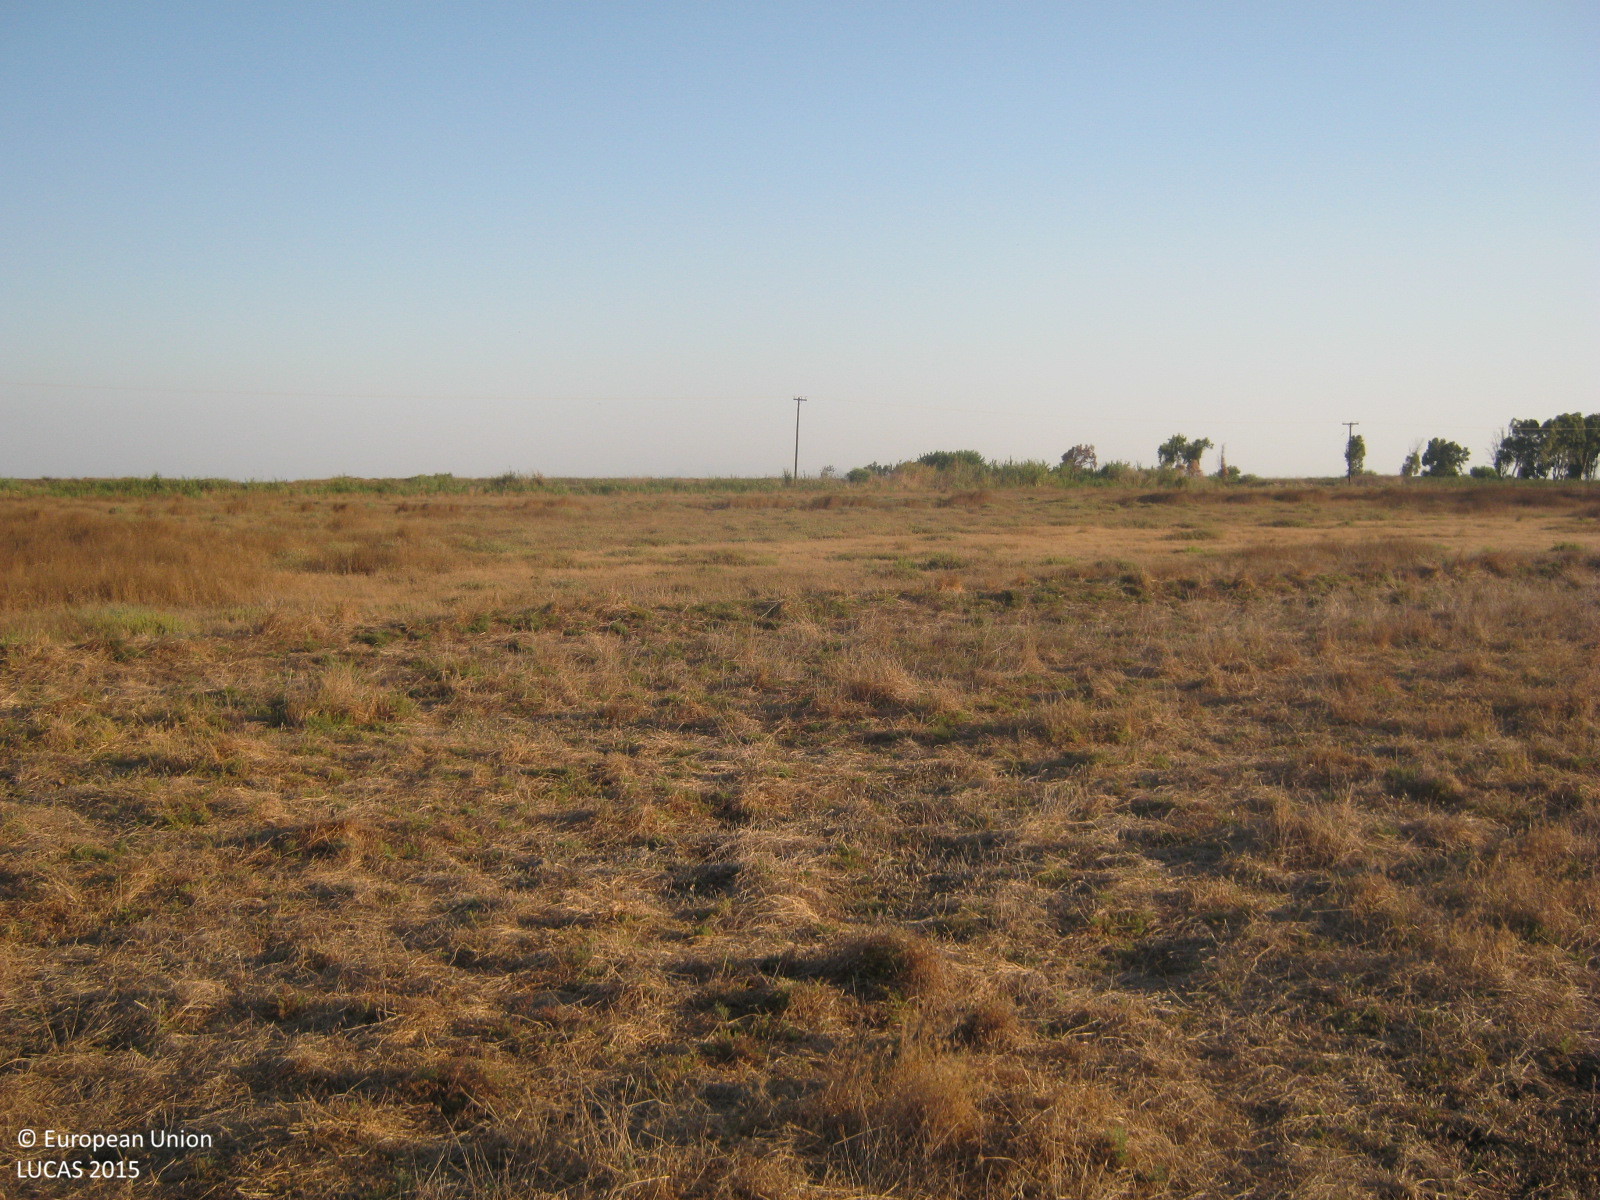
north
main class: Grassland
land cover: Spontaneously vegetated surfaces
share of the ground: > 75 %
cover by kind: herbaceous plants 100 %
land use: Agriculture (excluding fallow land and kitchen gardens)
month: August
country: GR
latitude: 37.9416
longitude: 21.2147
